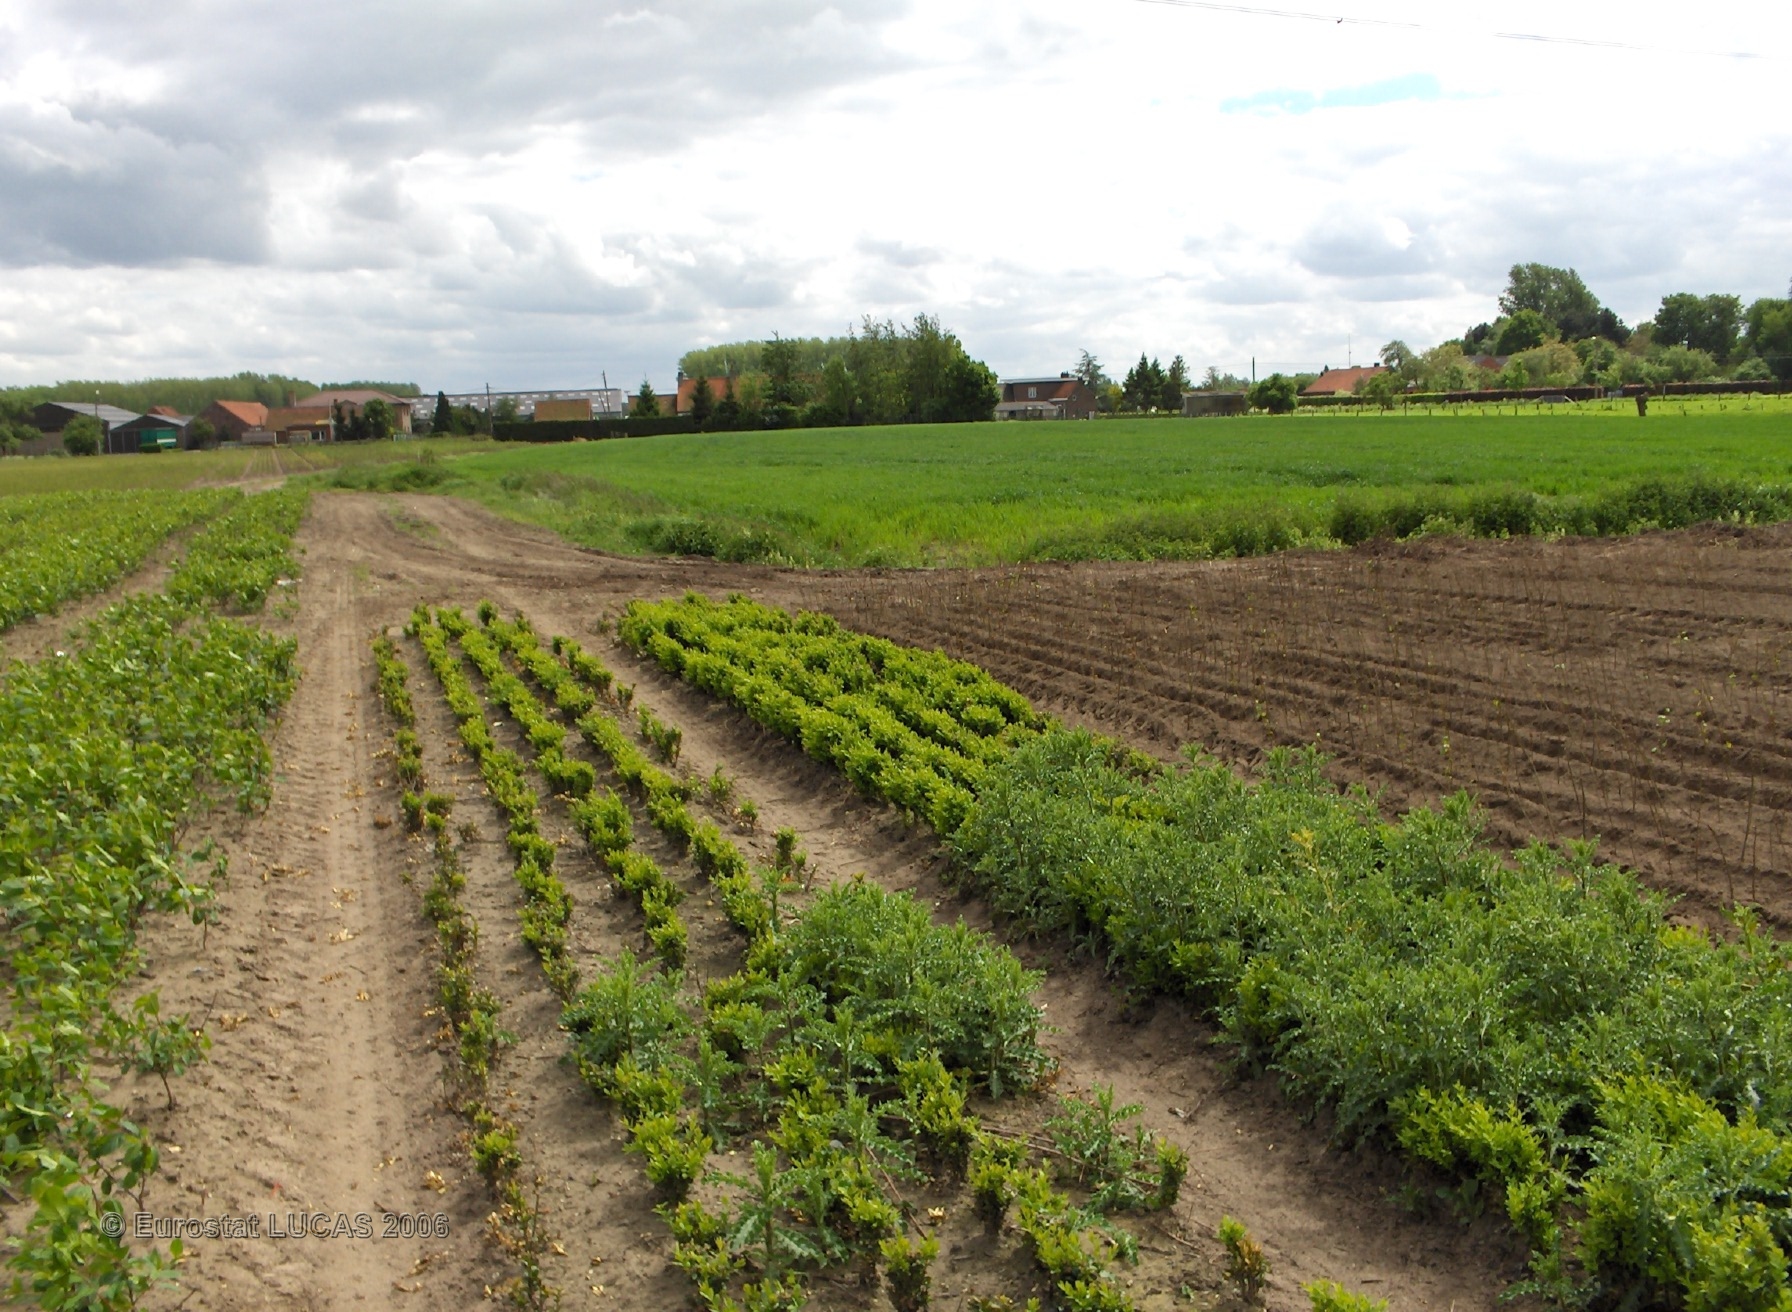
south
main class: Cropland
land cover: Nurseries
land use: Agriculture (excluding fallow land and kitchen gardens)
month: May
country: BE
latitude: 51.1441
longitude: 3.6605
